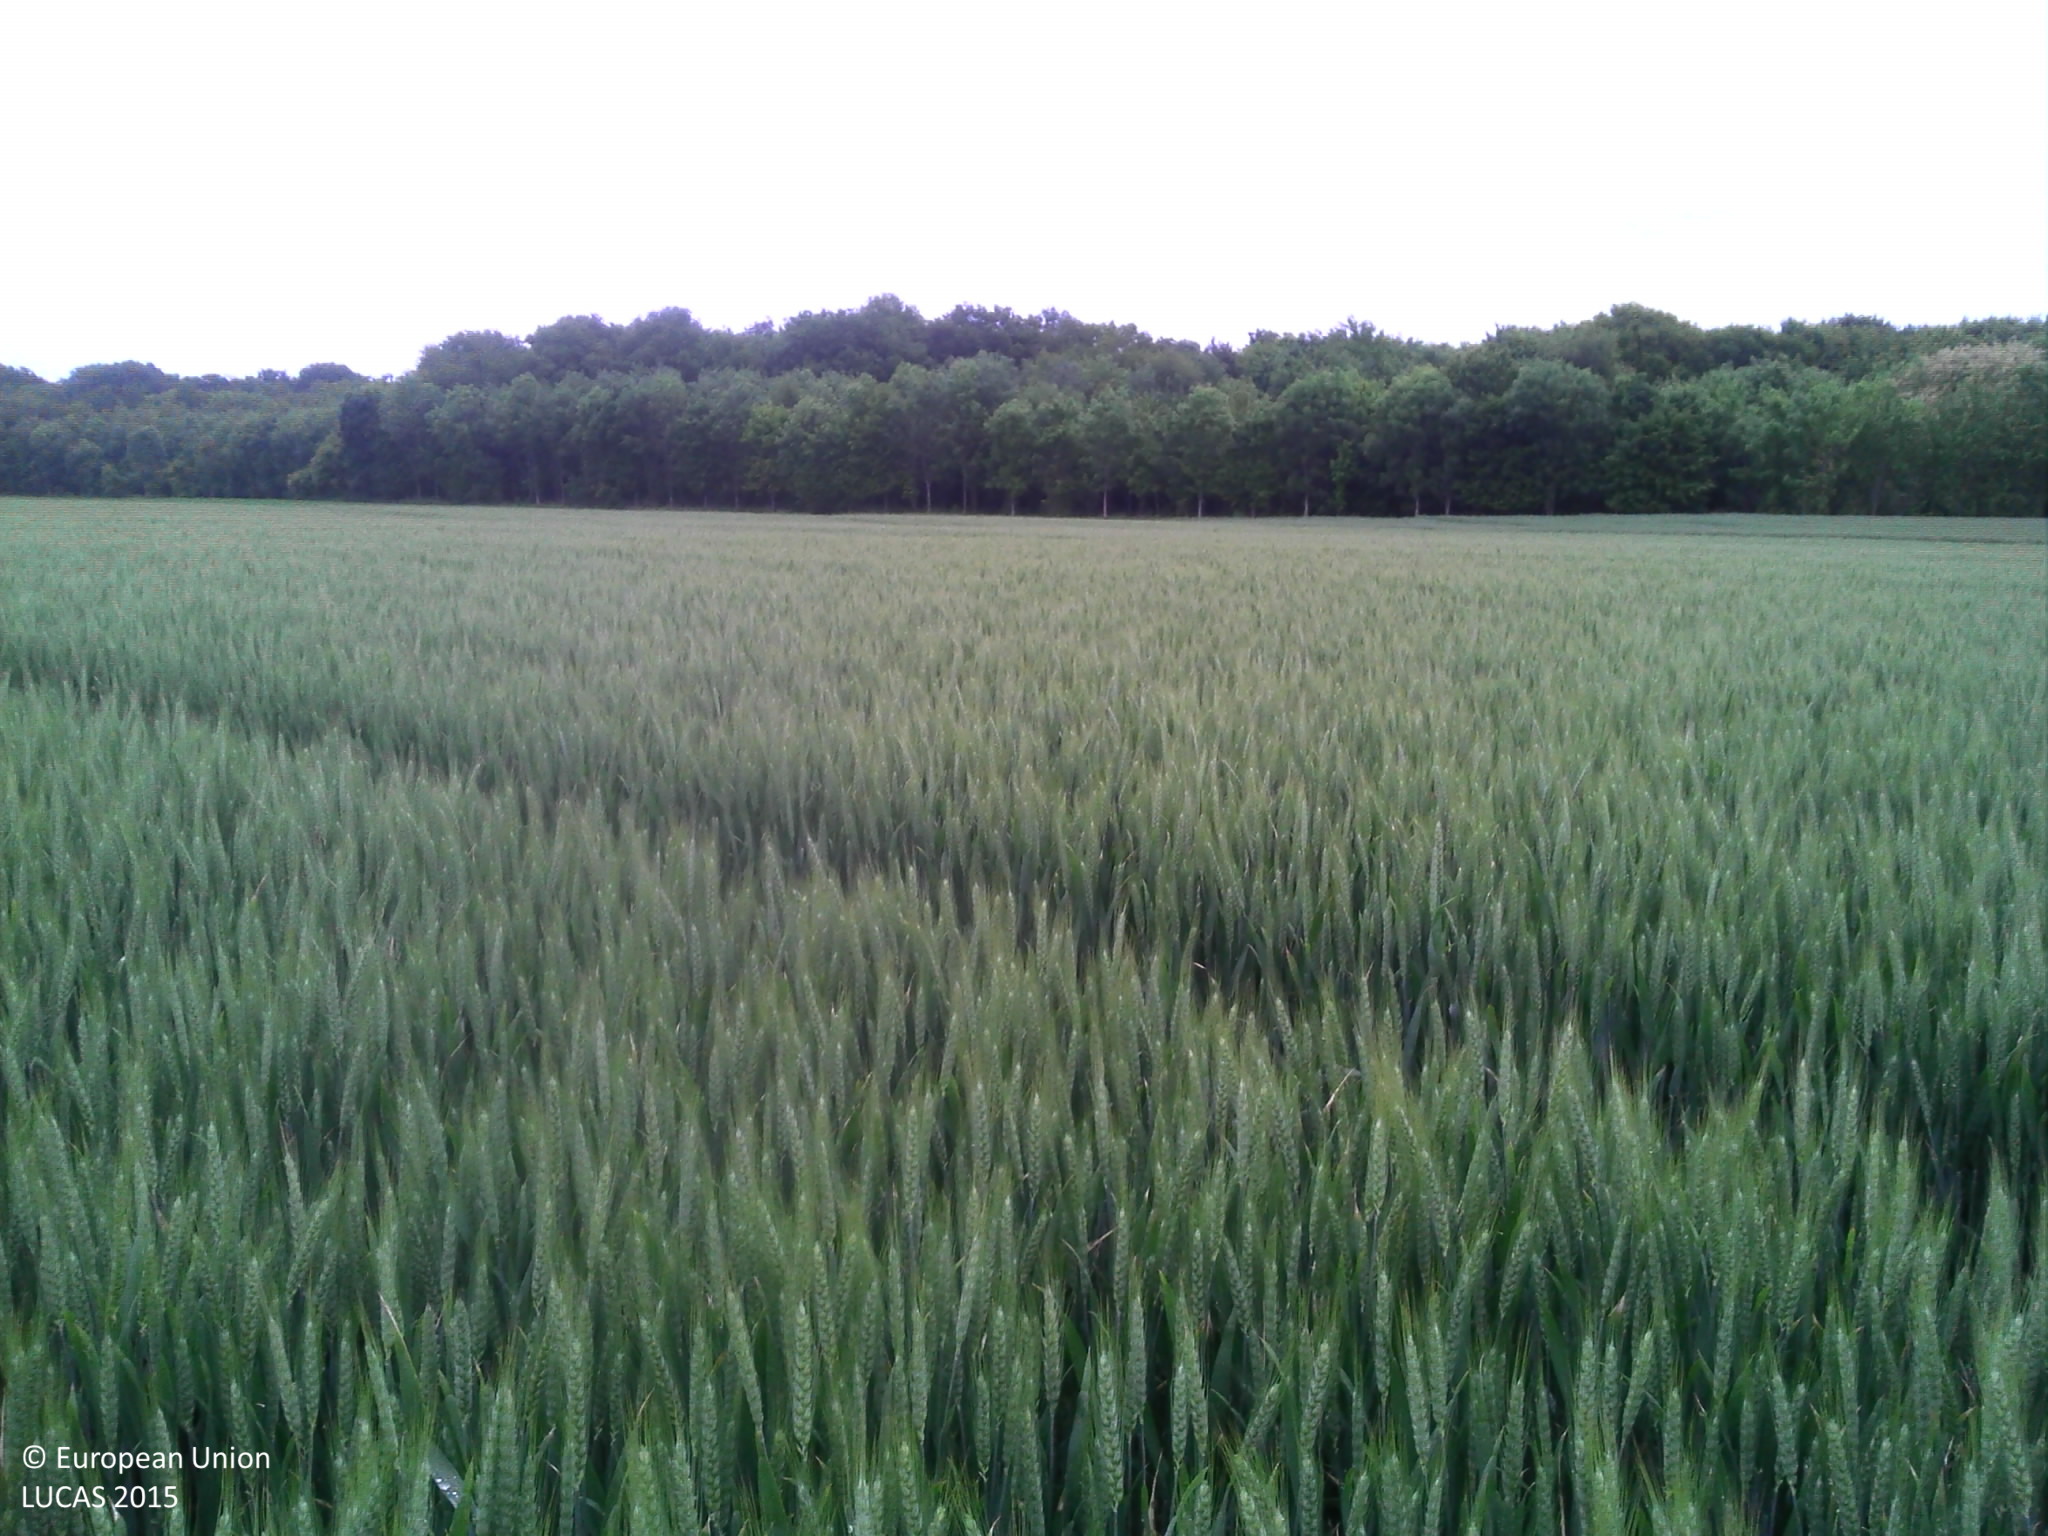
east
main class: Cropland
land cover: Durum wheat
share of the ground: > 75 %
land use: Agriculture (excluding fallow land and kitchen gardens)
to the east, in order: Durum wheat; Grass margins; Paved roads, cycling and walking lanes; Grass margins; Sugar beet; Broadleaved woodland; Sugar beet
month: June
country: FR
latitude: 49.8971
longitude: 2.1759
